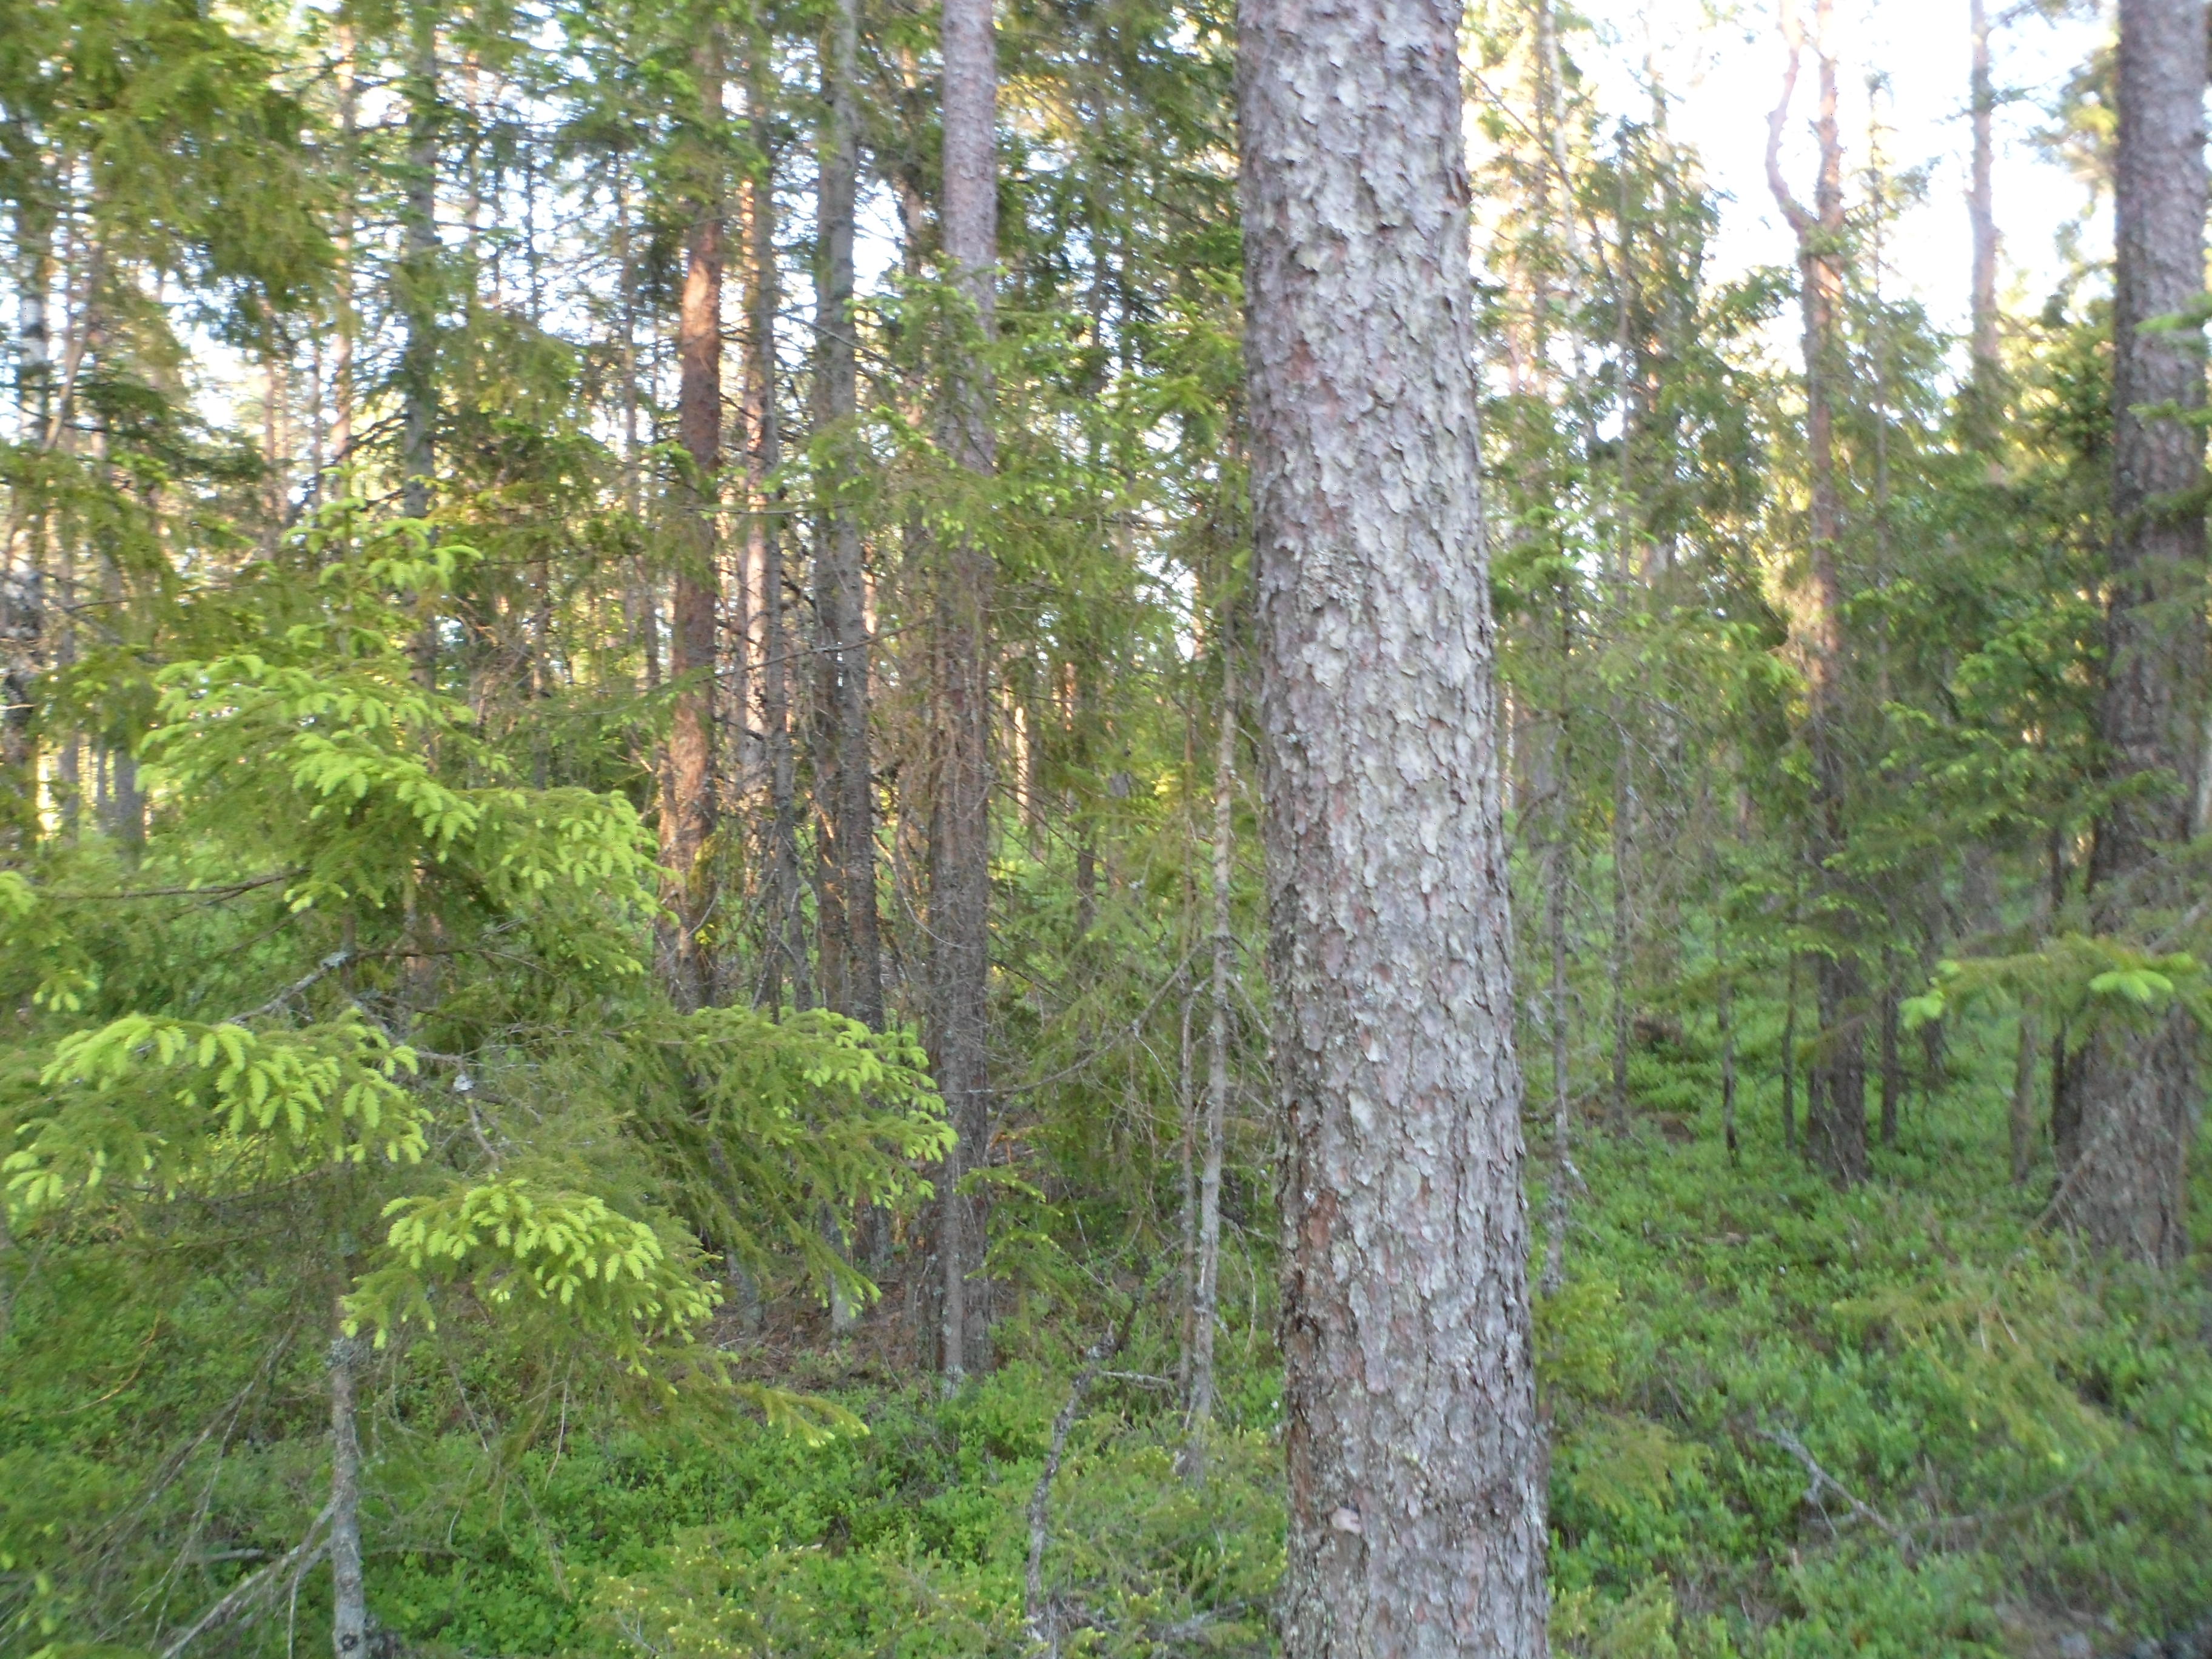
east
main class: Woodland
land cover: Pine dominated coniferous woodland
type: boreal forest
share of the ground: 25 - 50 %
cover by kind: coniferous forest trees 40 %, shrubs 25 %, herbaceous plants 15 %, lichens and mosses 15 %, broadleaved forest trees 5 %
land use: Forestry
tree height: > 5 m
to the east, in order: Pine dominated coniferous woodland; Ditches and canals; Pine dominated mixed woodland; Tracks; Grassland with sparse tree/shrub cover; Paved roads, cycling and walking lanes; Ditches and canals; Spruce dominated coniferous woodland
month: June
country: SE
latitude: 57.4962
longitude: 13.9166
